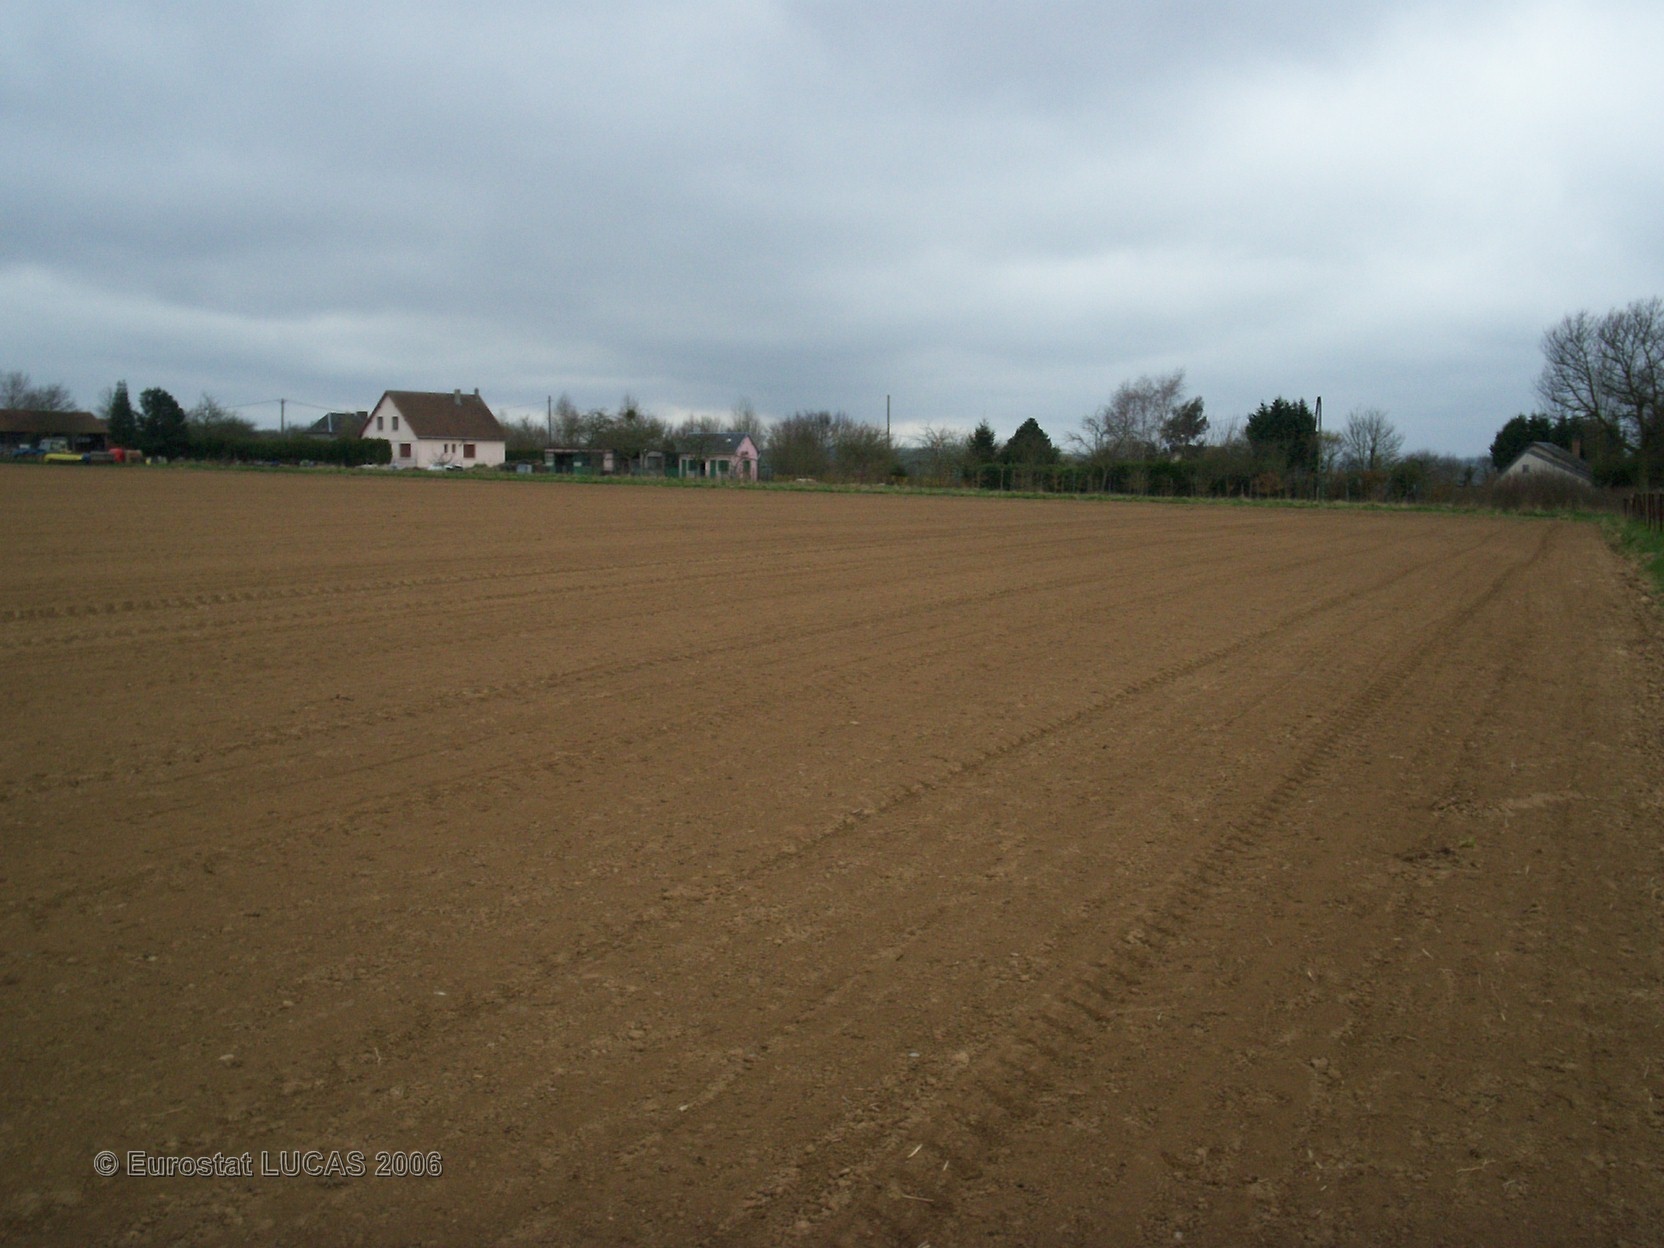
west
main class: Grassland
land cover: Grassland without tree/shrub cover
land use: Agriculture (excluding fallow land and kitchen gardens)
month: April
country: FR
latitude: 49.5145
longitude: 0.9302
